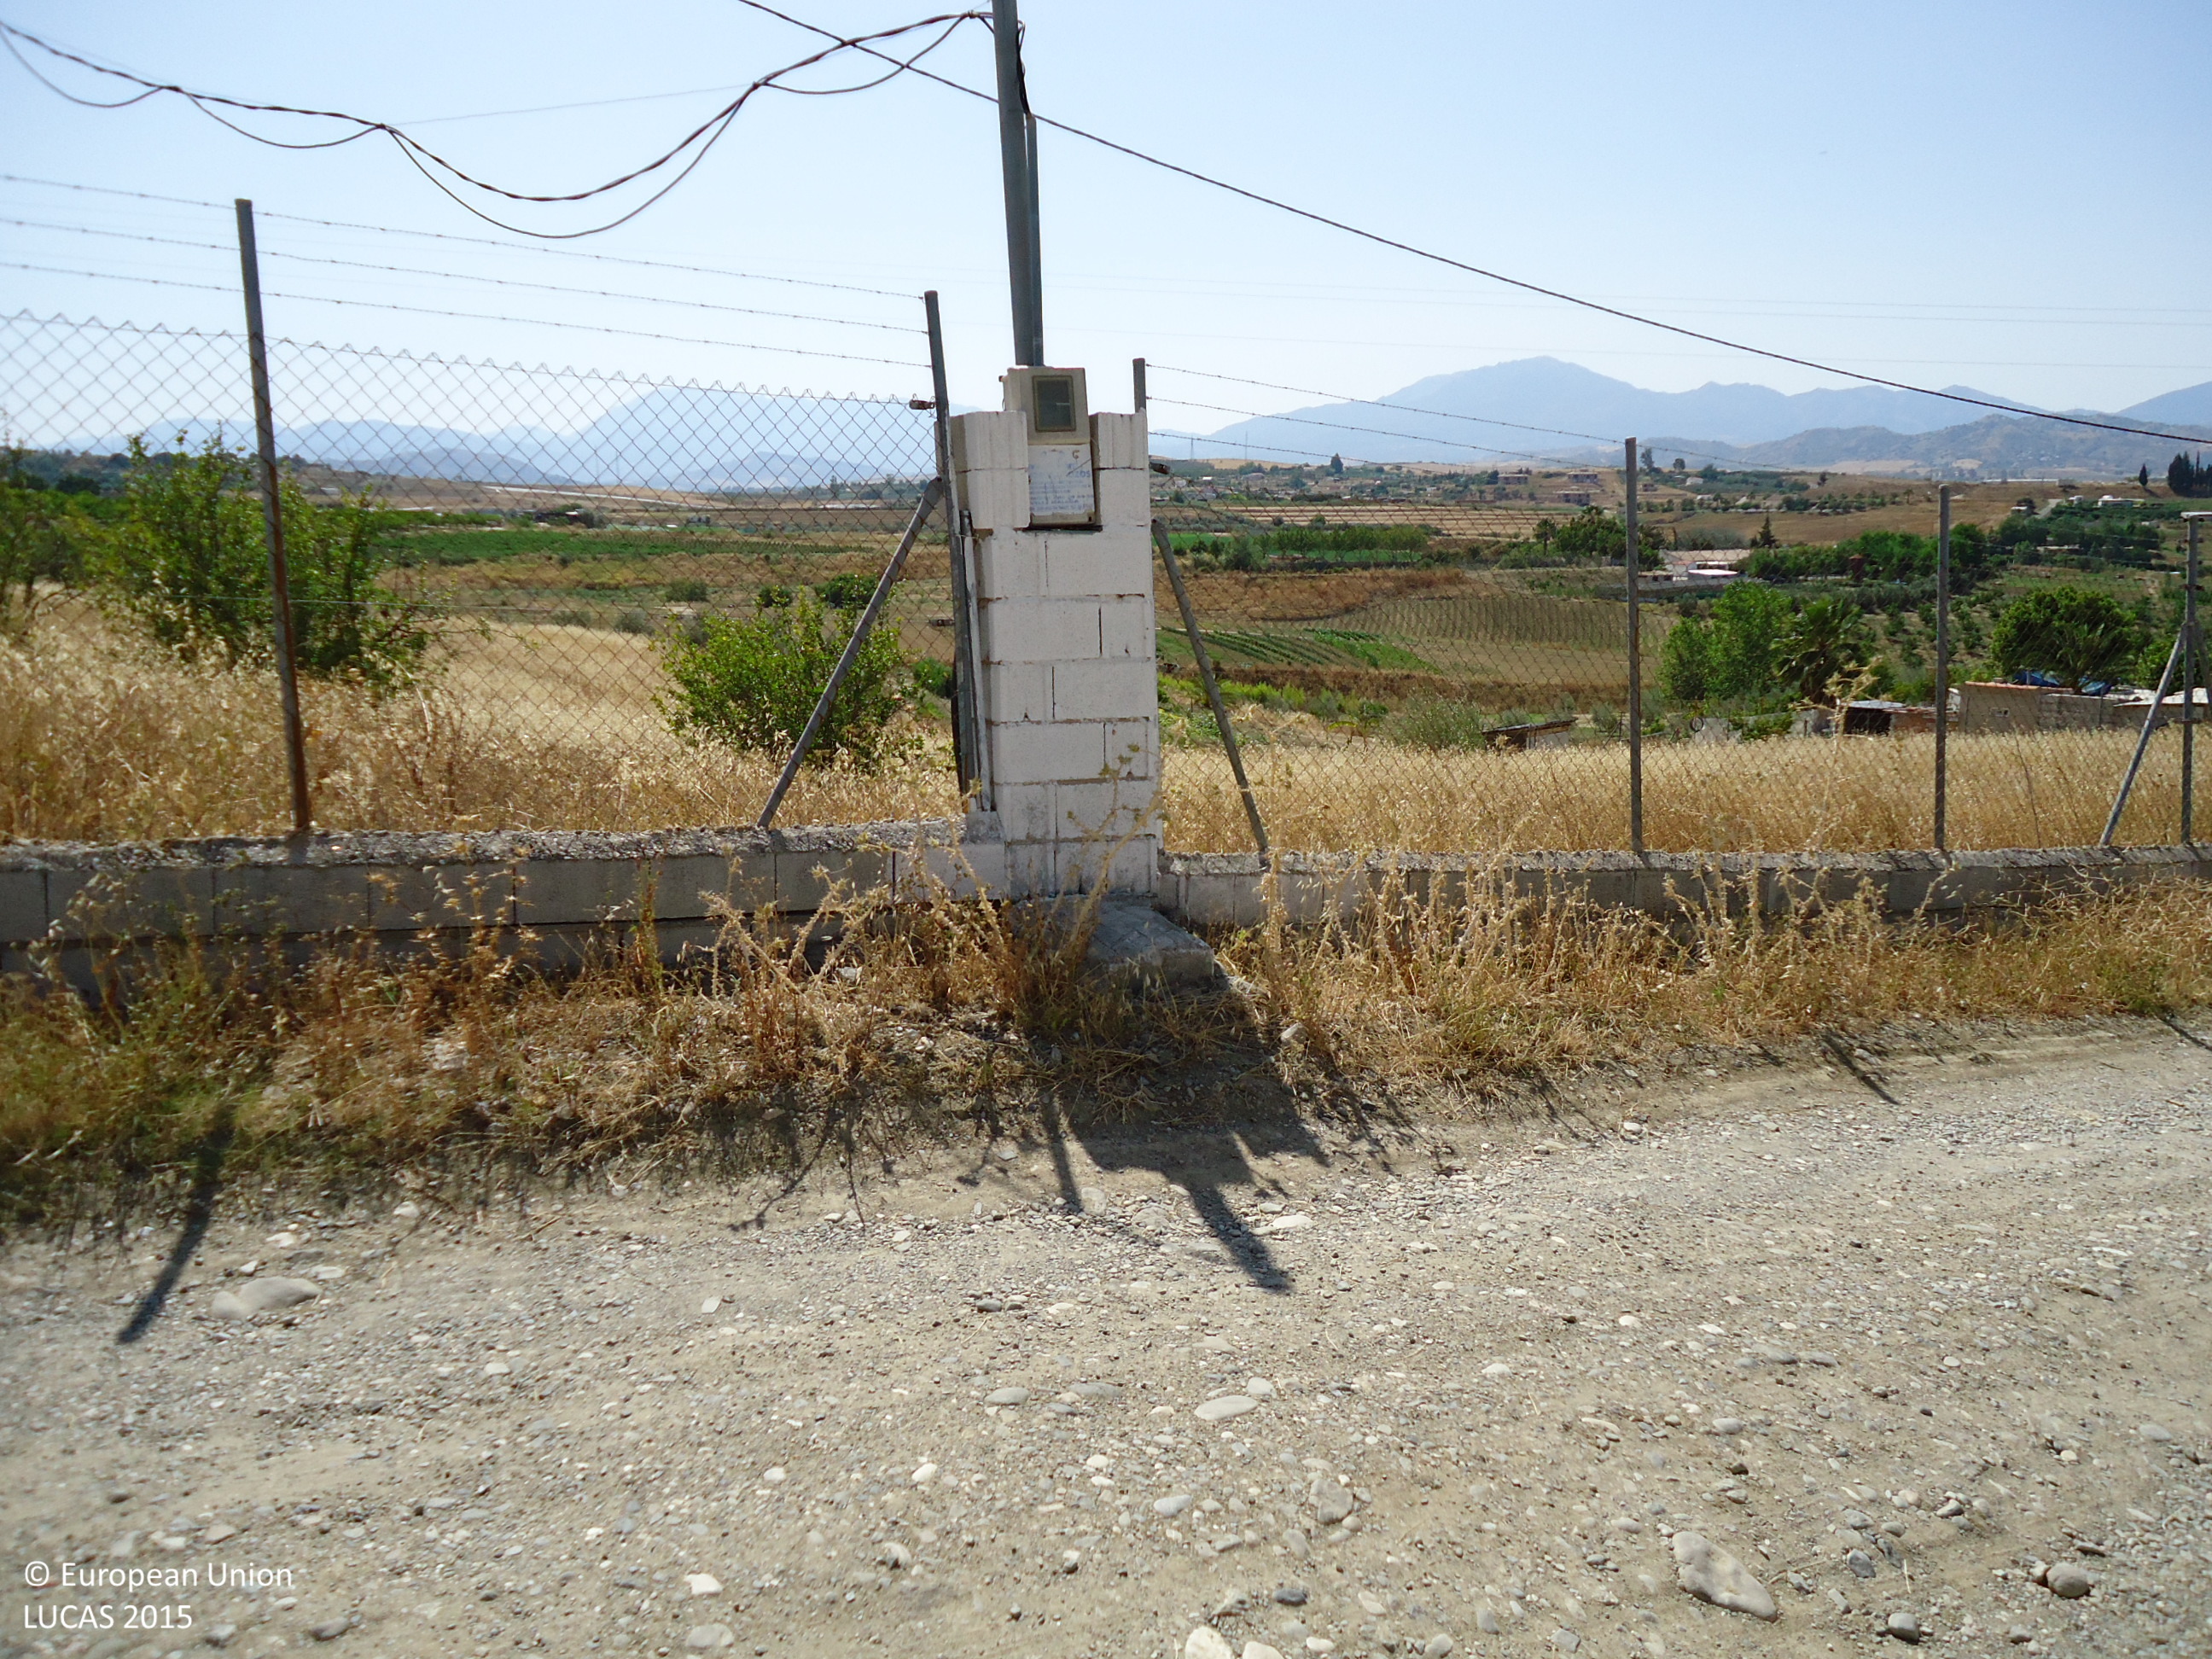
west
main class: Cropland
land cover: Other fresh vegetables
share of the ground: 25 - 50 %
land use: Kitchen garden
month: June
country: ES
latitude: 36.7102
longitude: -4.6913
